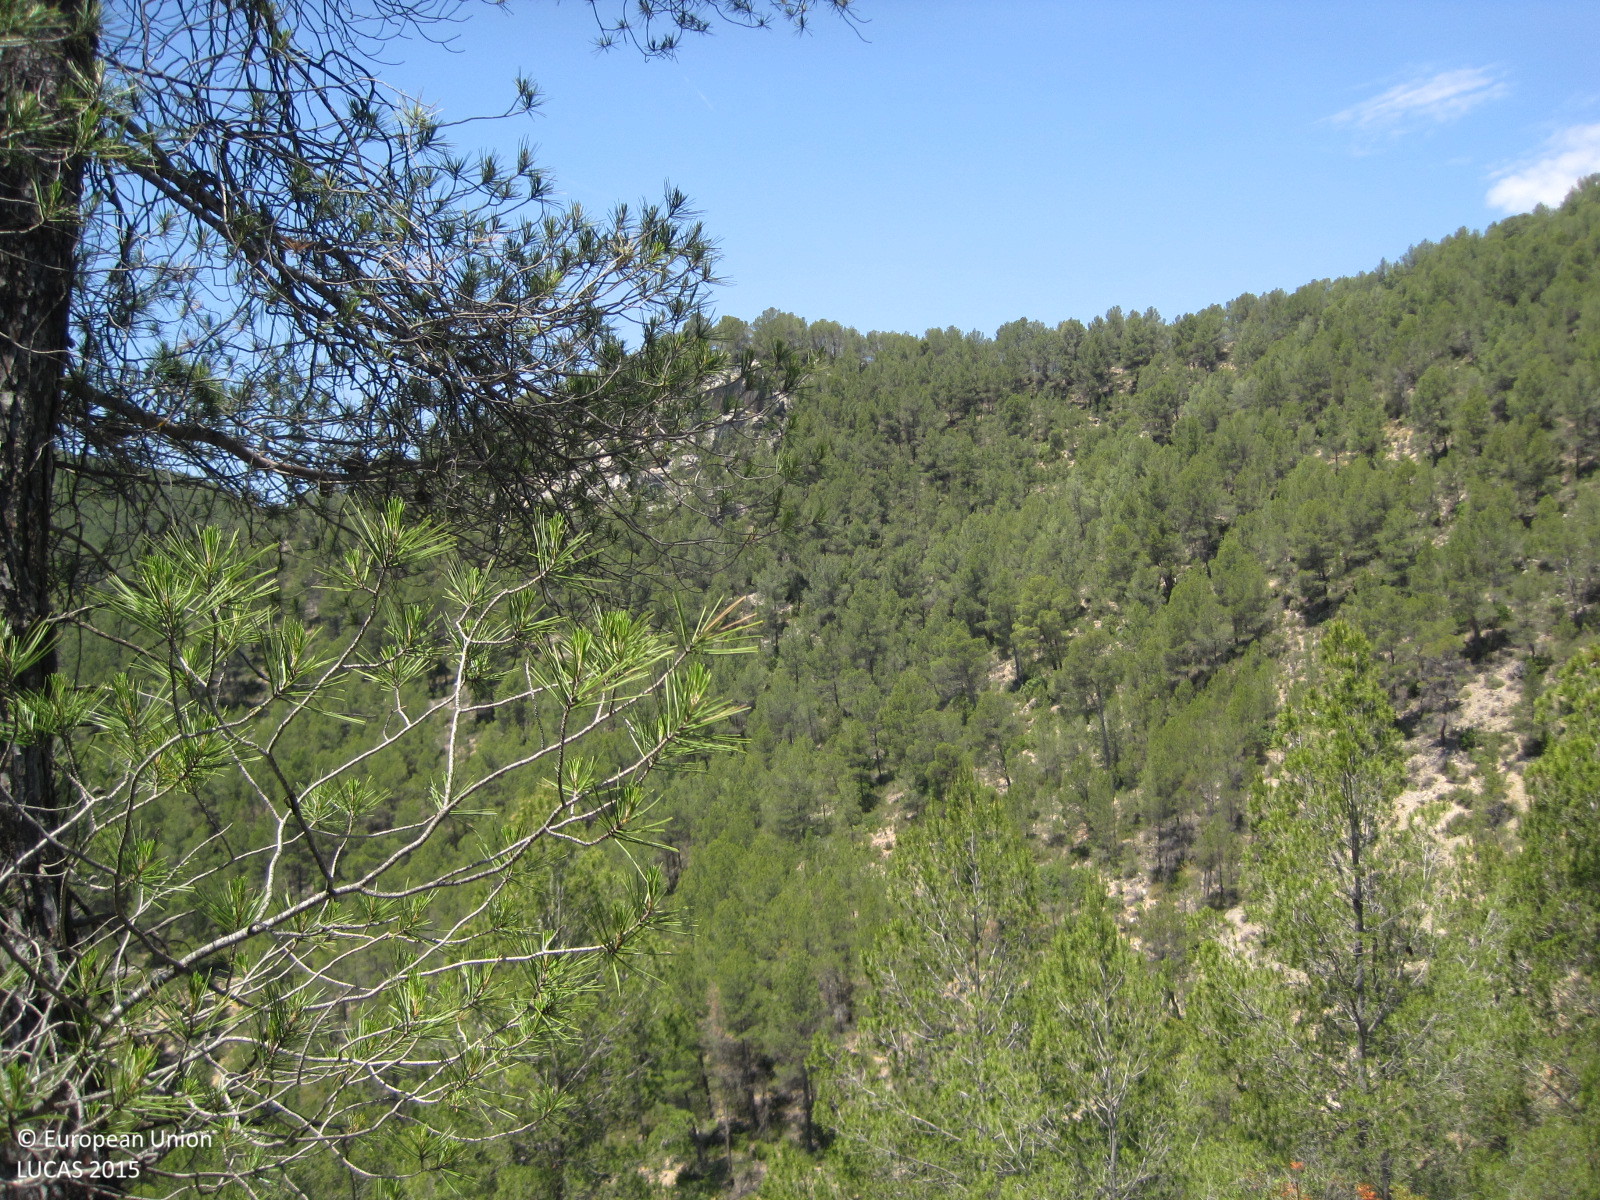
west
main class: Woodland
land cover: Pine dominated coniferous woodland
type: coniferous forest of the mediterranean region
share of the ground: 25 - 50 %
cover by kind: coniferous forest trees 40 %, shrubs 30 %, herbaceous plants 20 %, consolidated bare surface 10 %
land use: Forestry
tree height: > 5 m
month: June
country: ES
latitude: 39.7931
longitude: -1.1576
